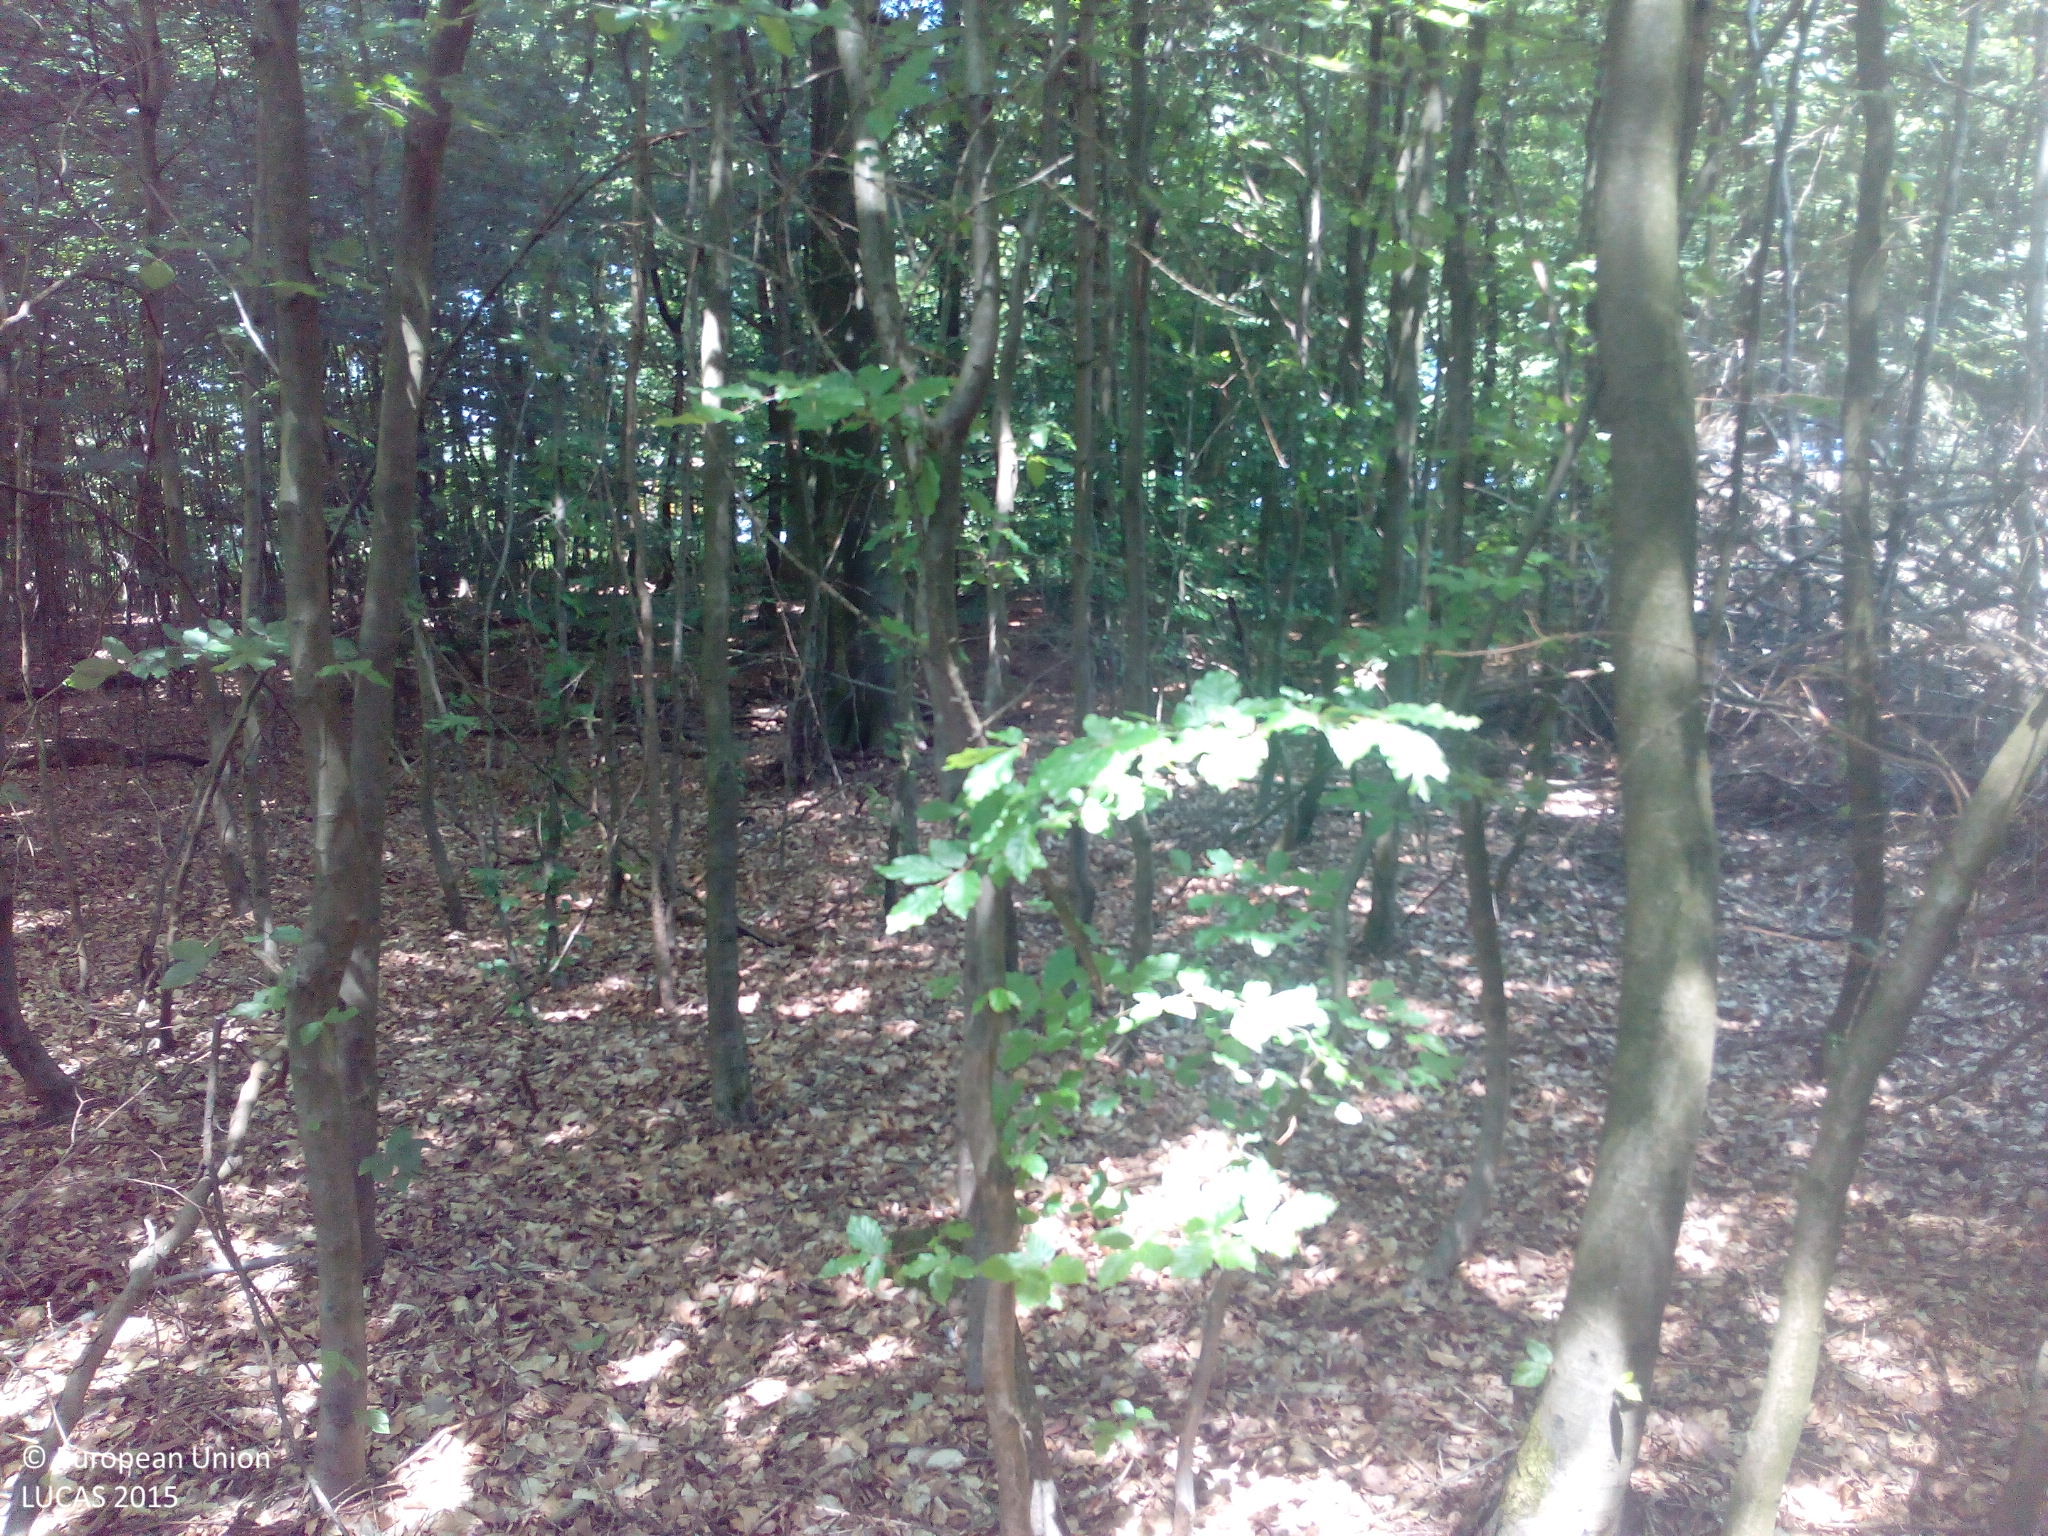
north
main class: Woodland
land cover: Broadleaved woodland
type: mesophytic deciduous forest
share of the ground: > 75 %
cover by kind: broadleaved forest trees 95 %, unconsolidated bare surface 5 %
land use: Forestry
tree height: > 5 m
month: June
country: DE
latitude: 50.1147
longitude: 8.1125
